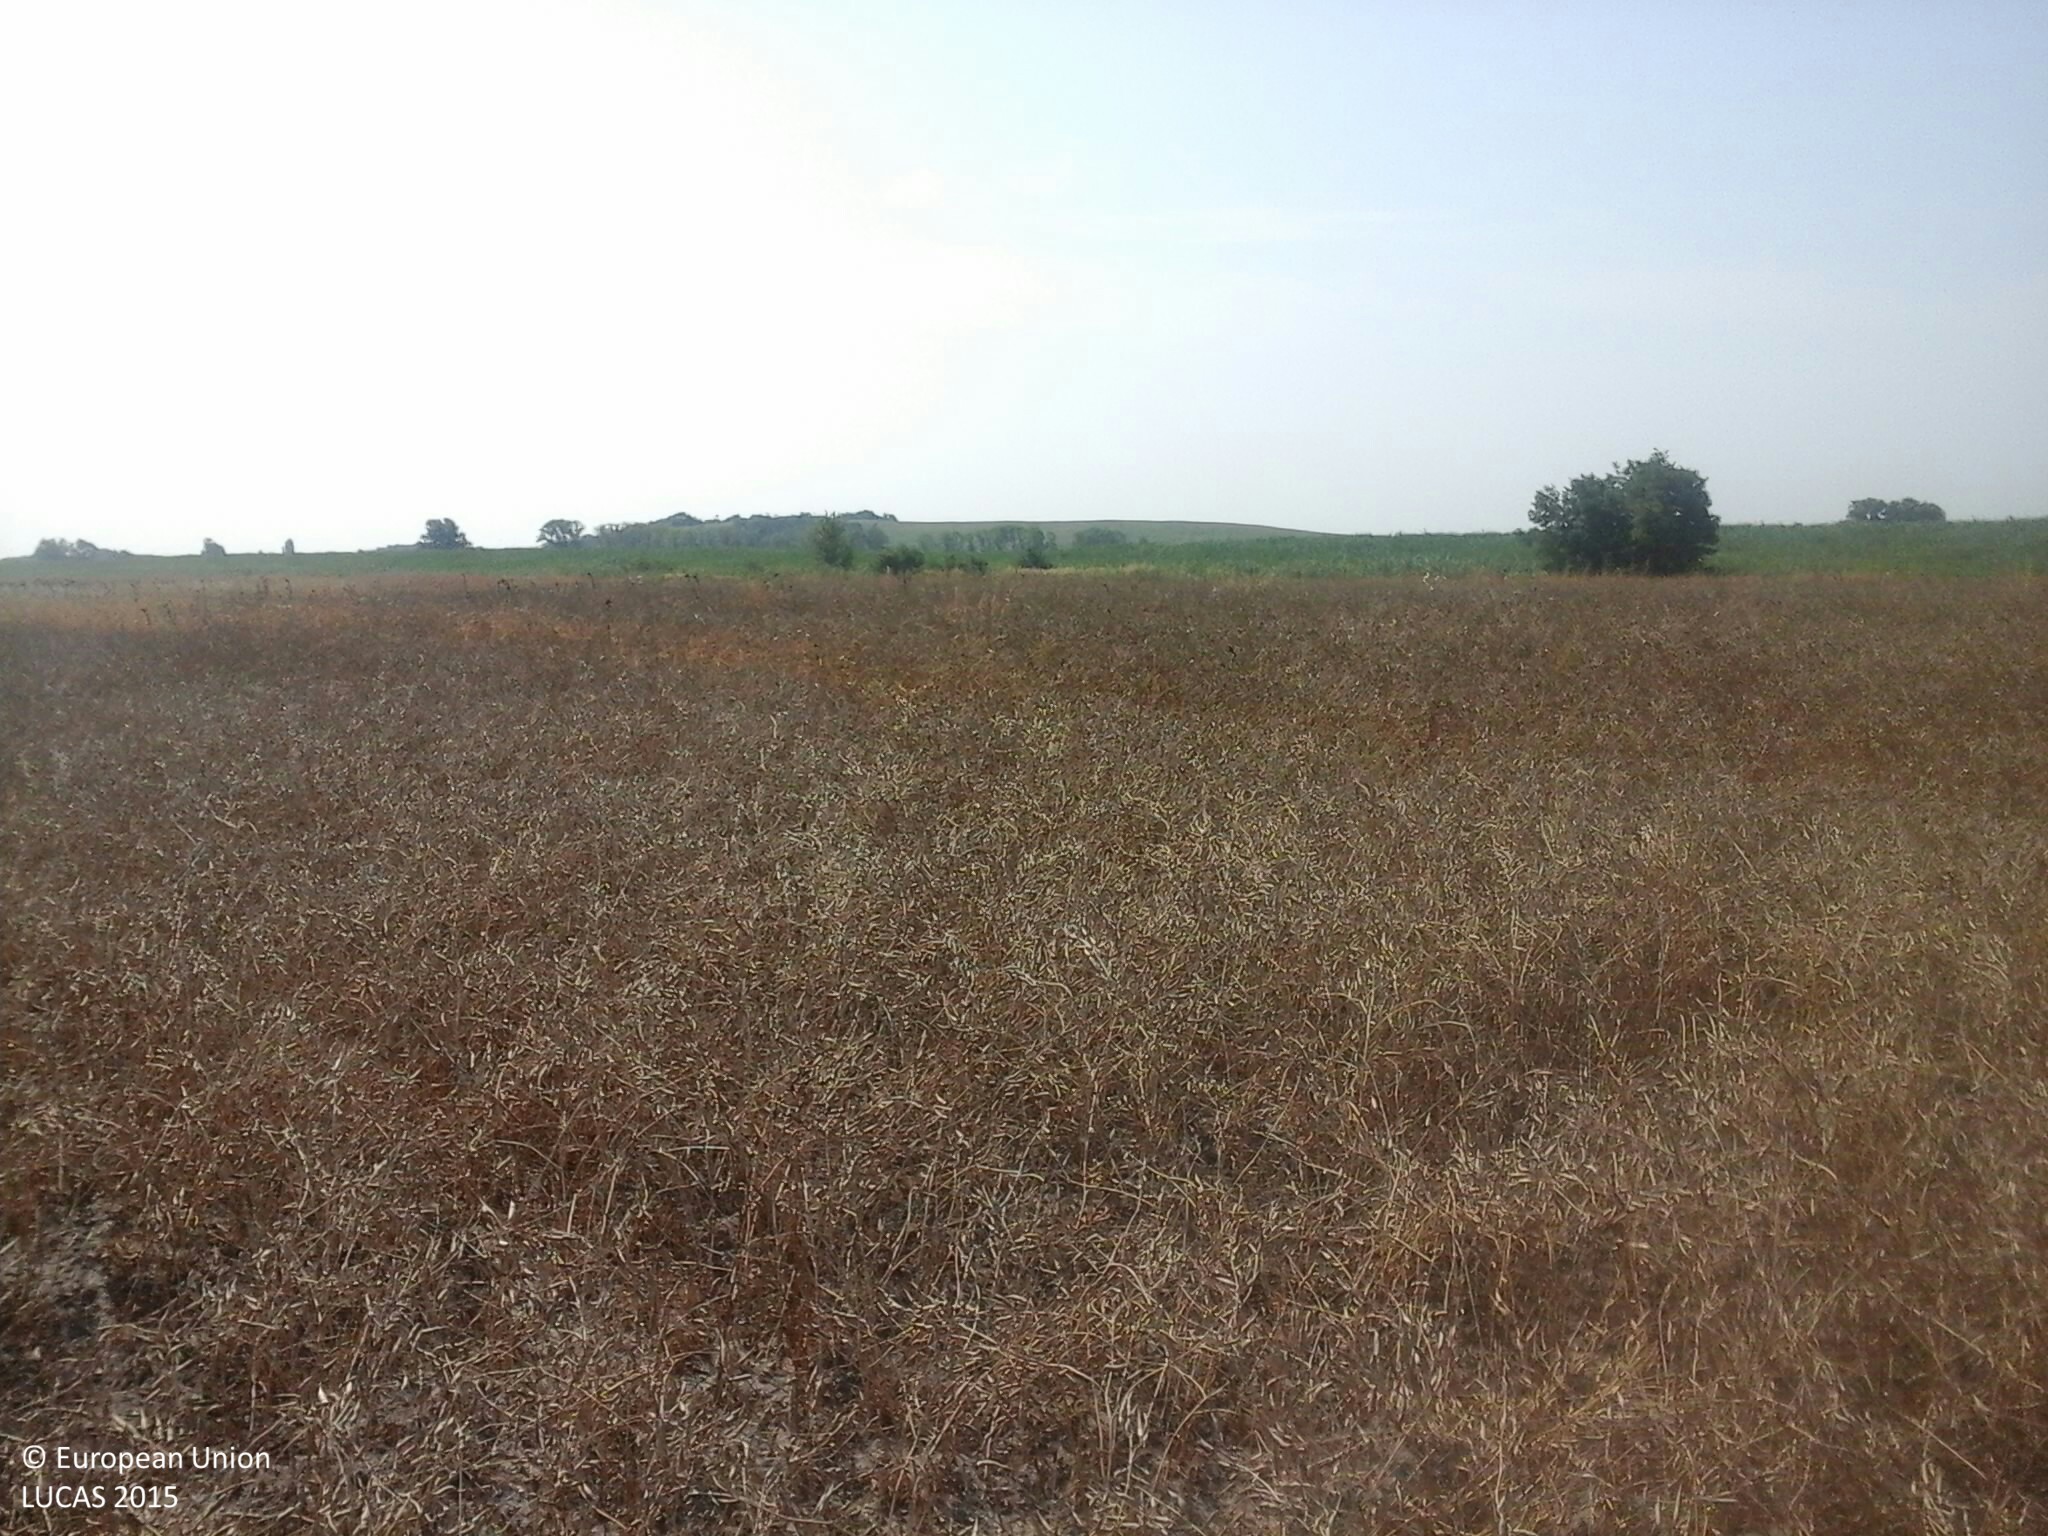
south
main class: Cropland
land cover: Other fresh vegetables
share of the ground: > 75 %
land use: Agriculture (excluding fallow land and kitchen gardens)
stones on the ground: < 10 %
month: August
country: HU
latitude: 46.8936
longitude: 18.1076
